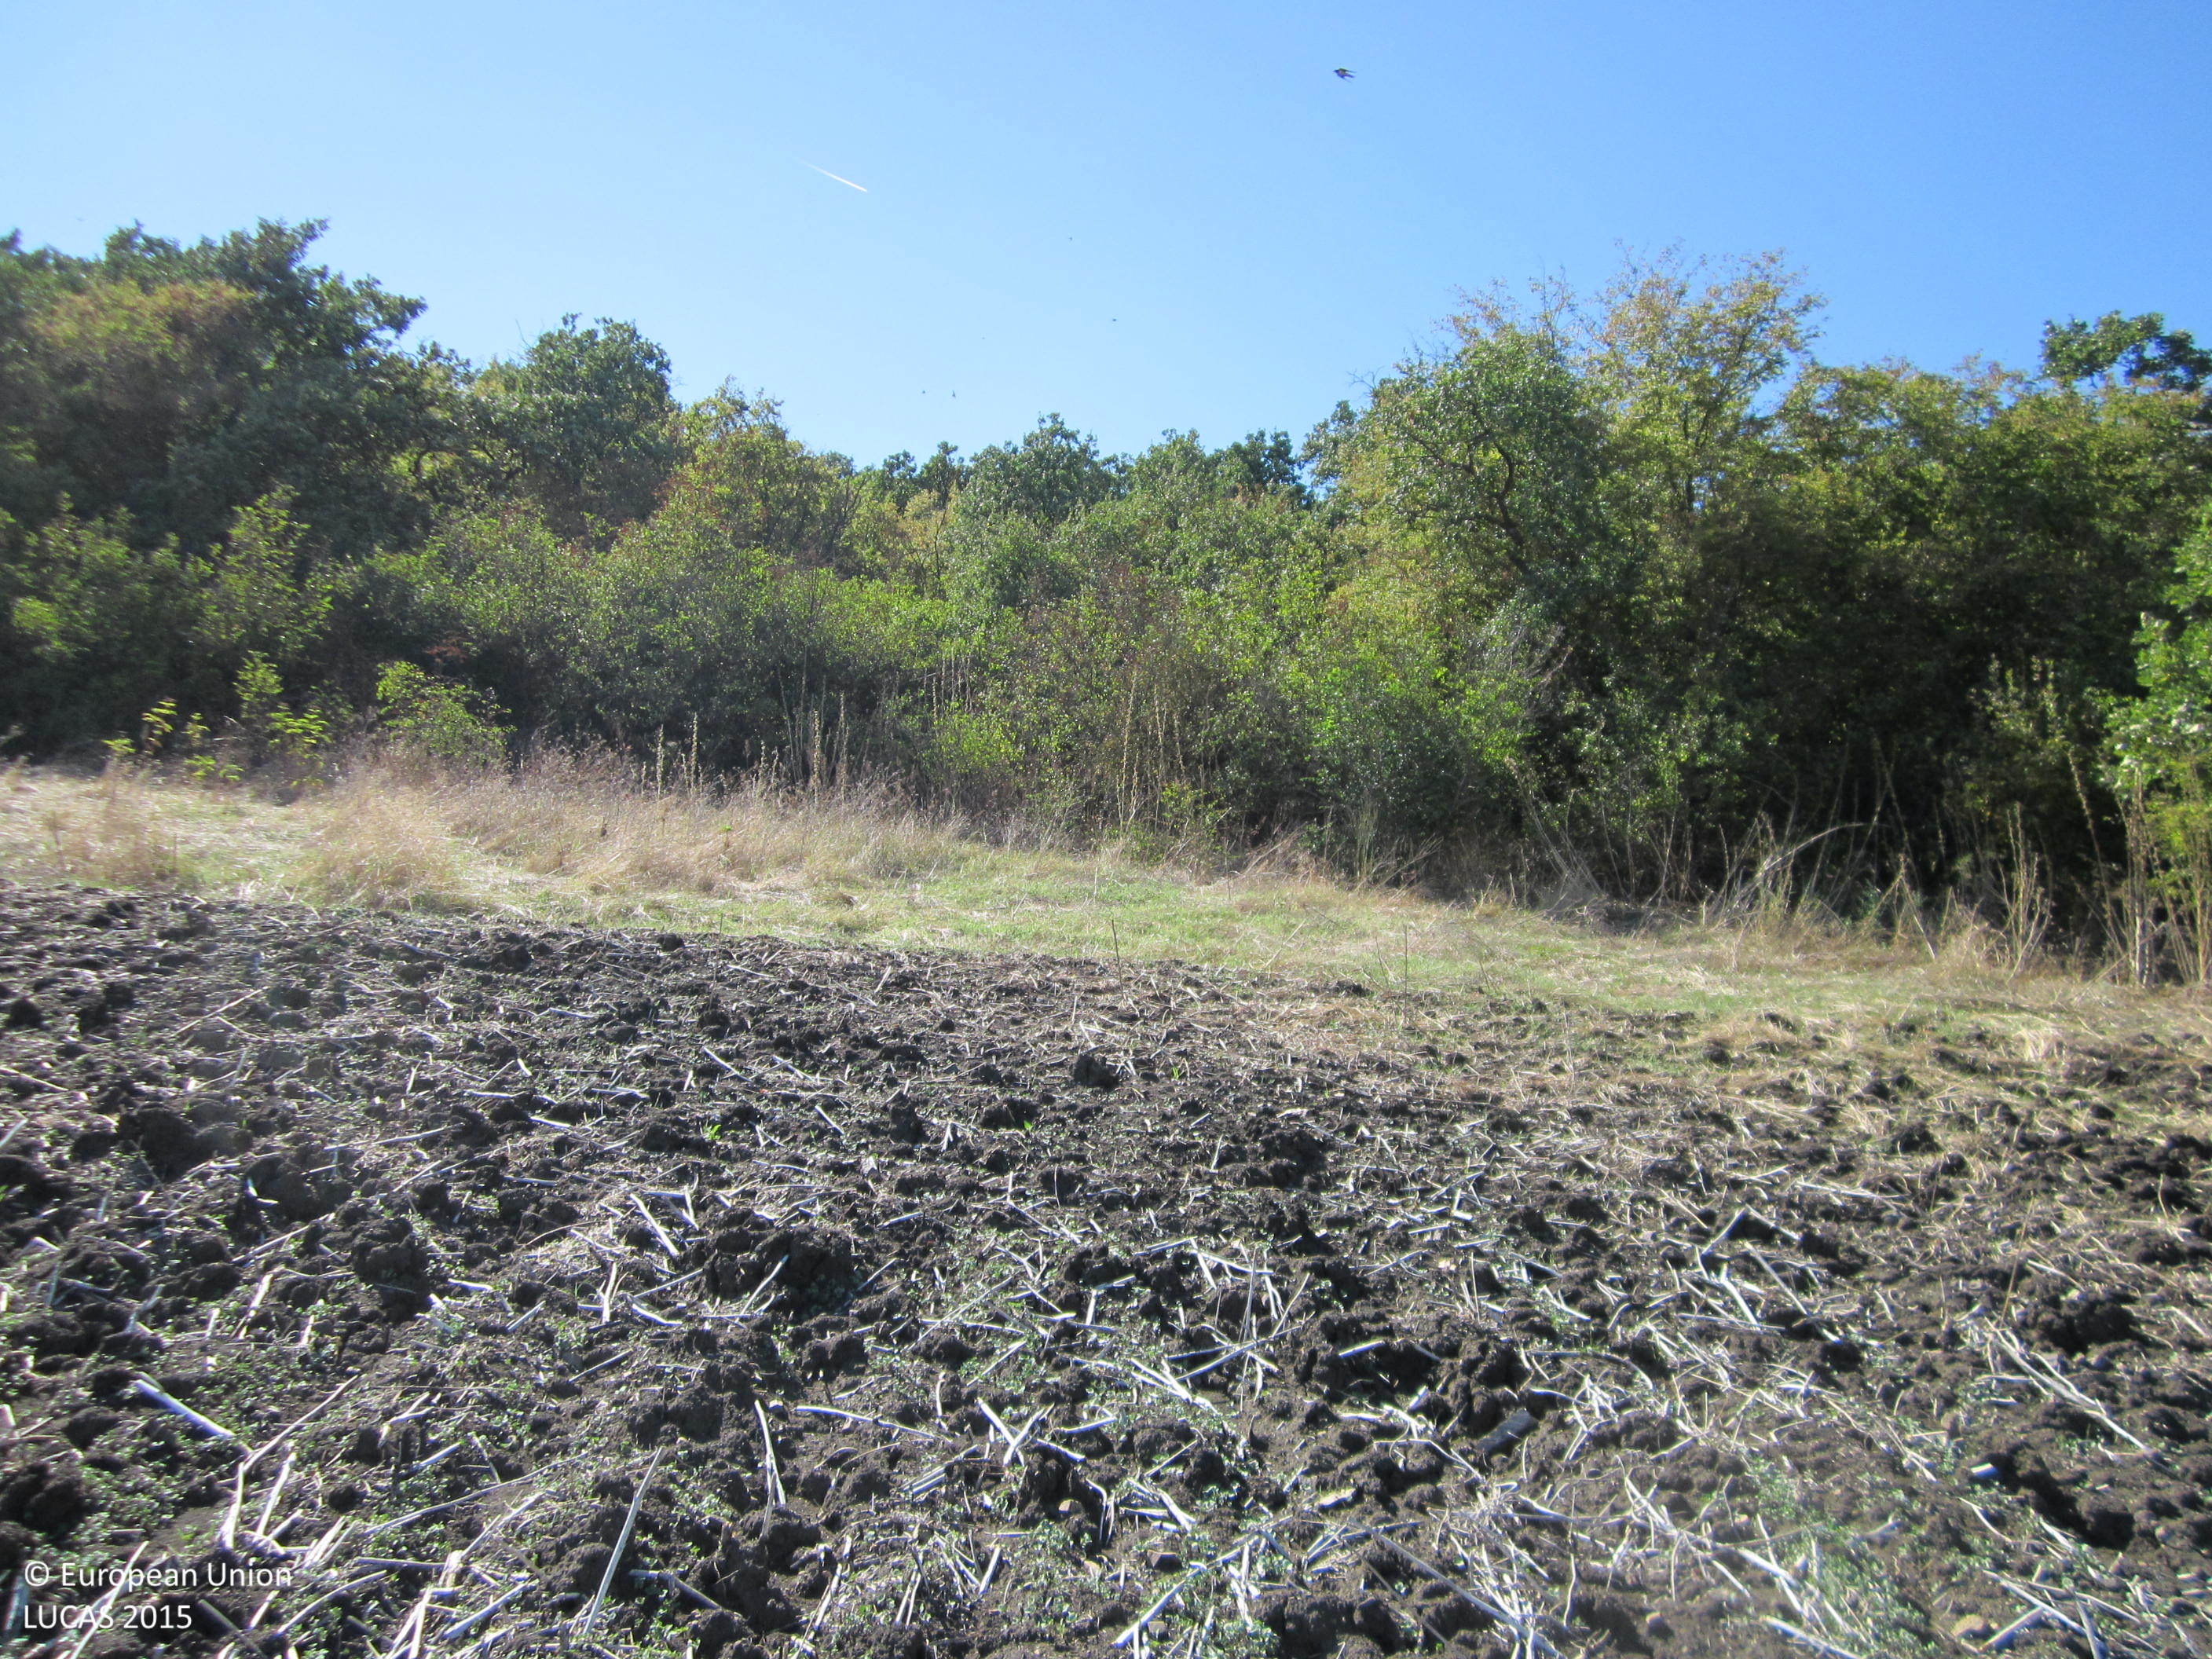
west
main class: Cropland
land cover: Sunflower
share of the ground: < 10 %
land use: Agriculture (excluding fallow land and kitchen gardens)
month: September
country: BG
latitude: 42.5020
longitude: 27.0574
